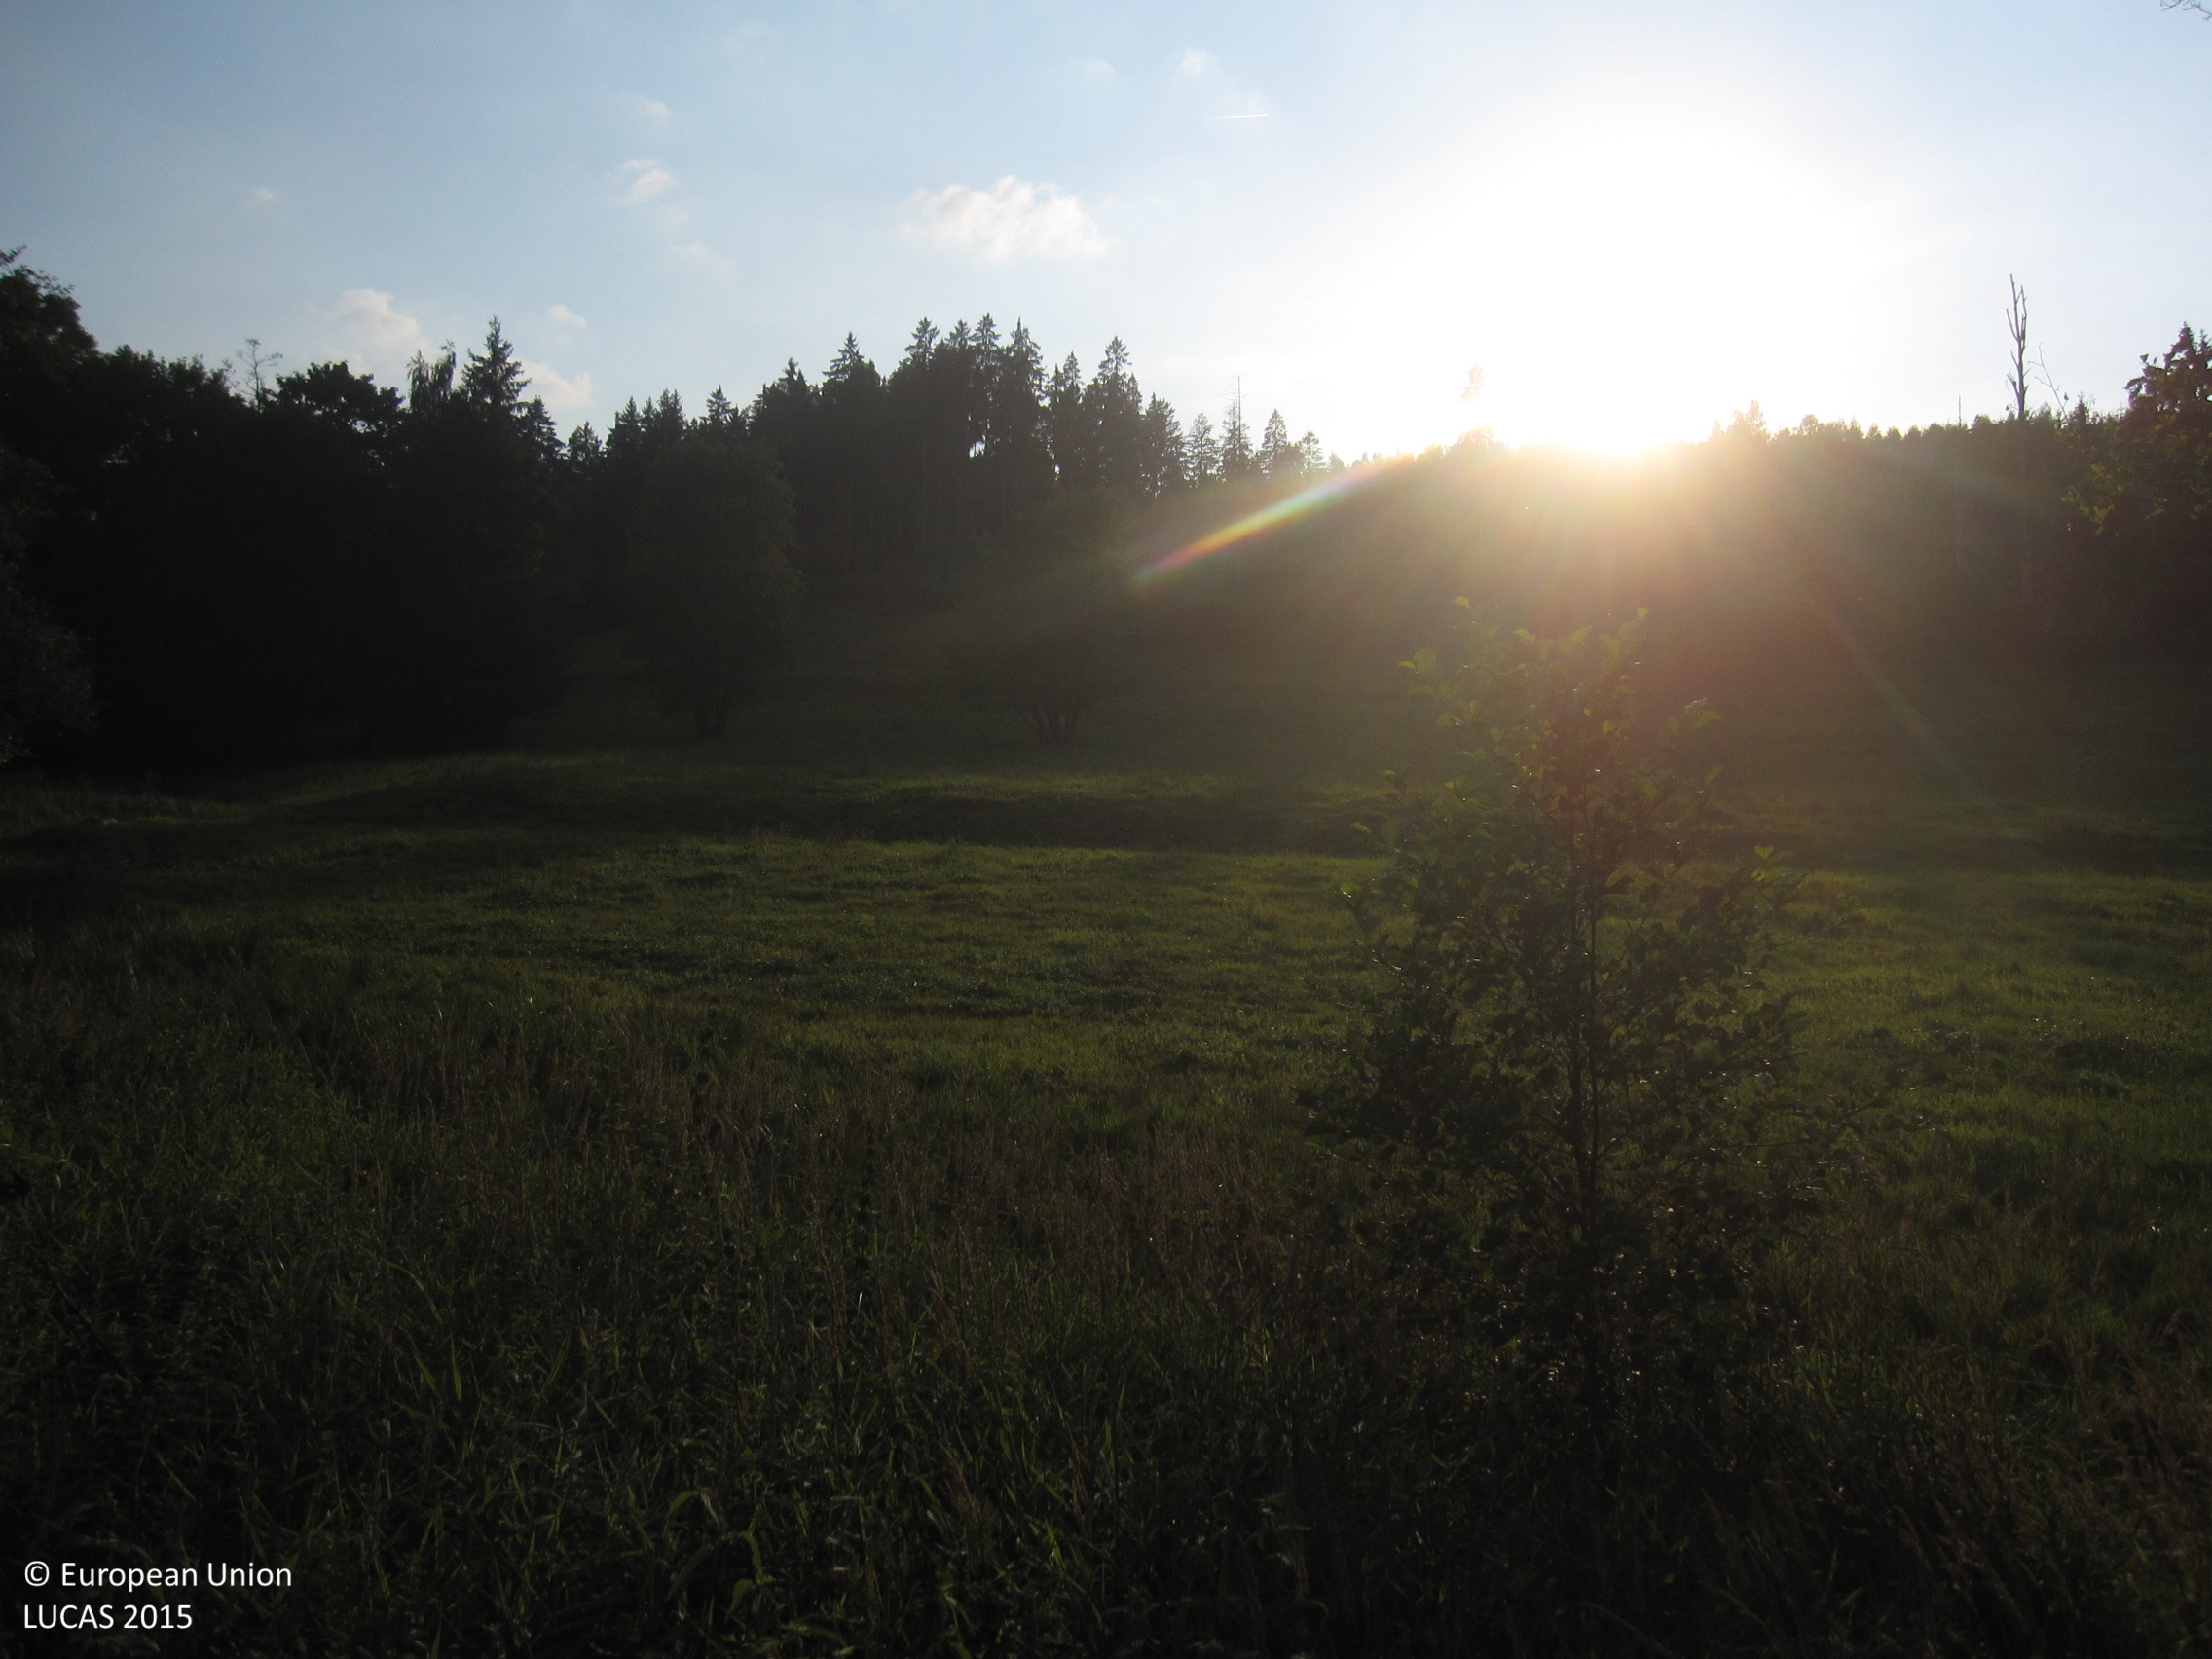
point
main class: Grassland
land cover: Grassland without tree/shrub cover
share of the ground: > 75 %
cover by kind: herbaceous plants 100 %
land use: Agriculture (excluding fallow land and kitchen gardens)
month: August
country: DE
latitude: 50.4796
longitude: 11.5357
